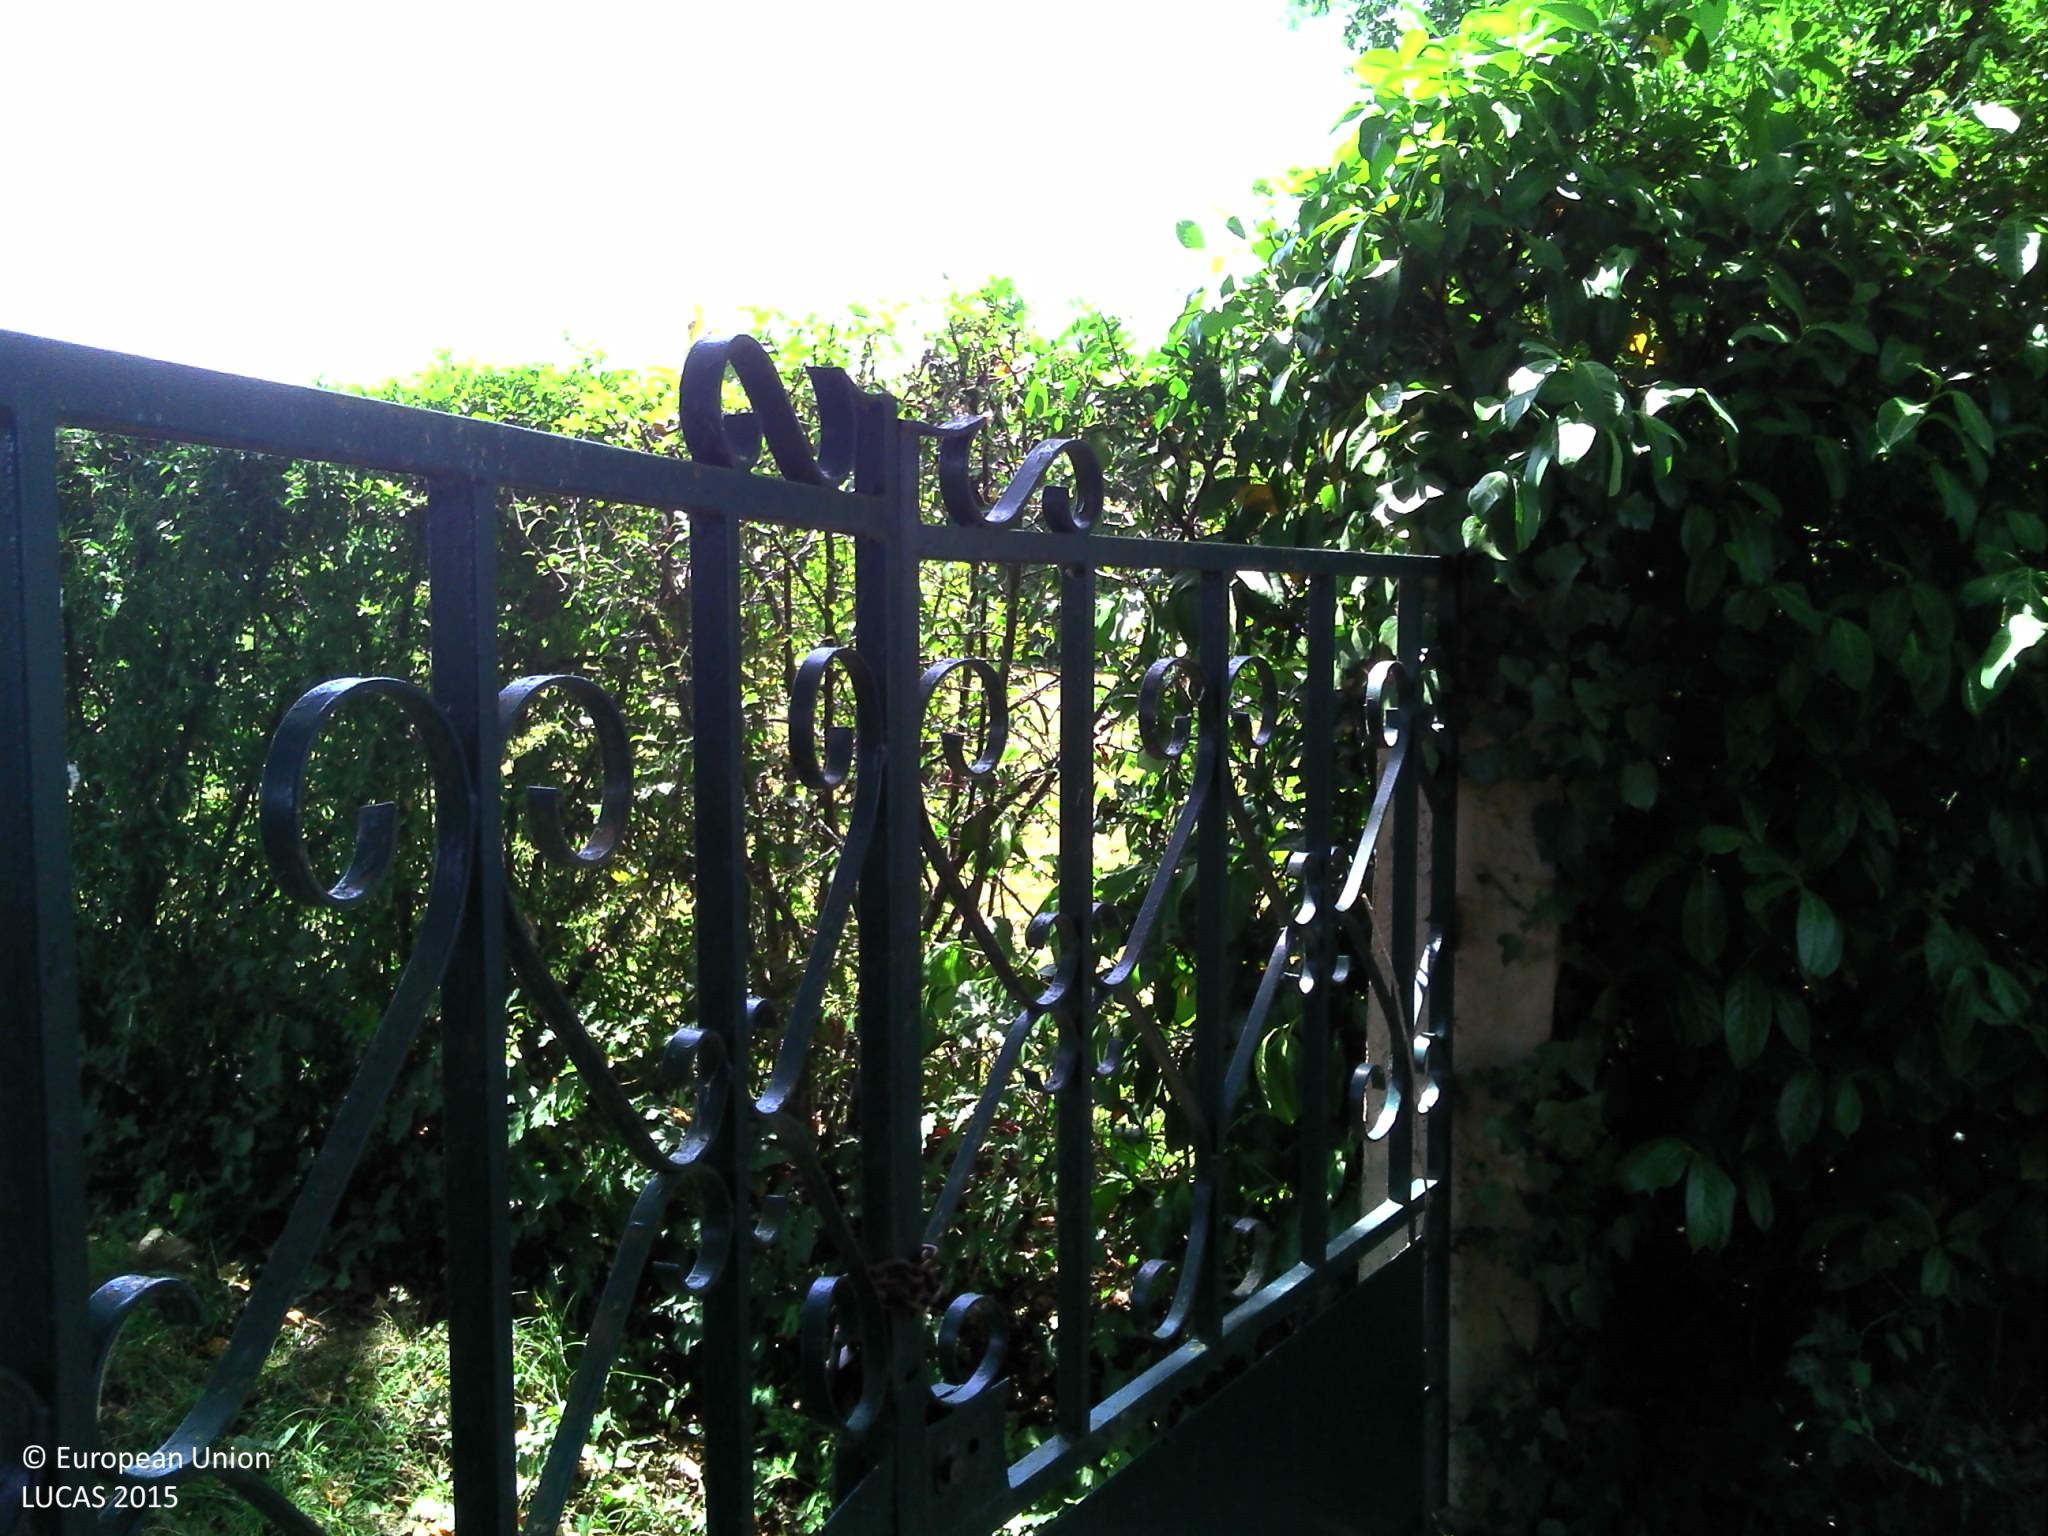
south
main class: Grassland
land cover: Grassland with sparse tree/shrub cover
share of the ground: > 75 %
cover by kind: herbaceous plants 95 %, broadleaved forest trees 5 %
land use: Residential
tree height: > 5 m
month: July
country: FR
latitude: 43.6816
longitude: 1.5800
